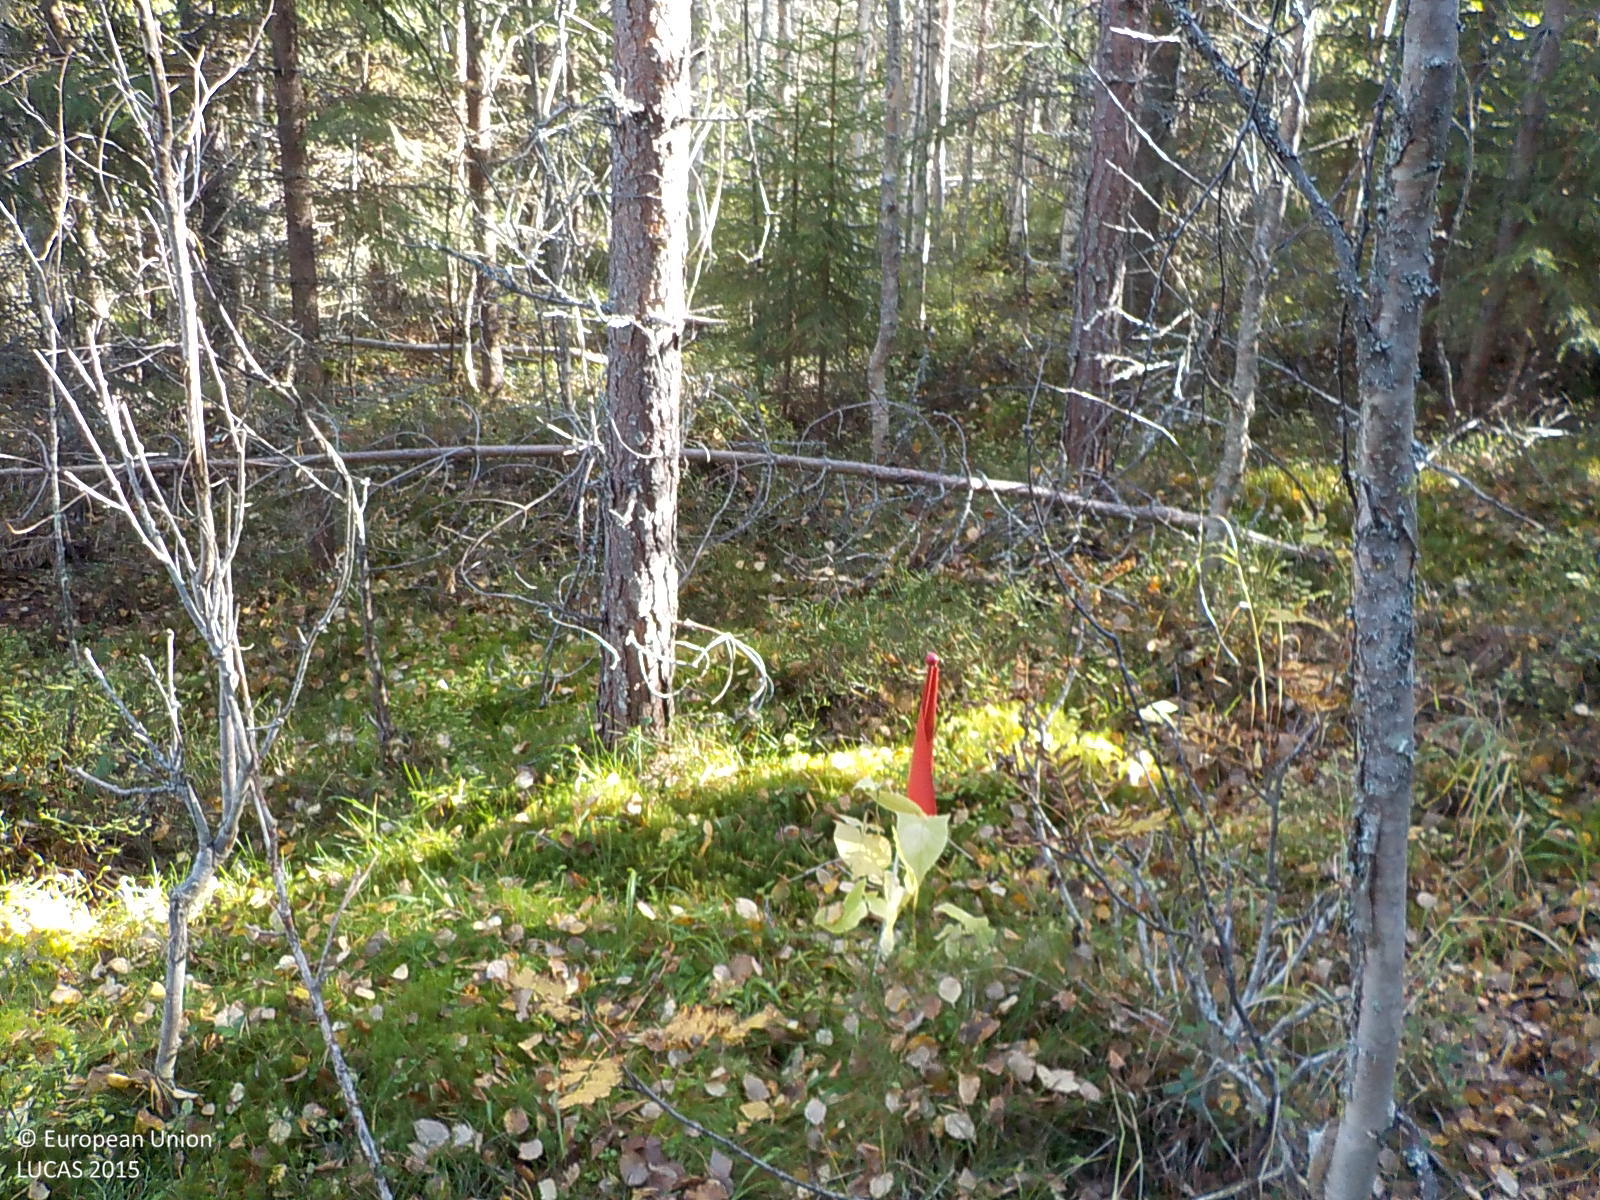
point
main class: Woodland
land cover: Other mixed woodland
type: boreal forest
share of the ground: > 75 %
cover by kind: coniferous forest trees 45 %, broadleaved forest trees 35 %, shrubs 10 %, herbaceous plants 10 %
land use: Forestry
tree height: > 5 m
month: September
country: SE
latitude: 63.4363
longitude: 17.2097
